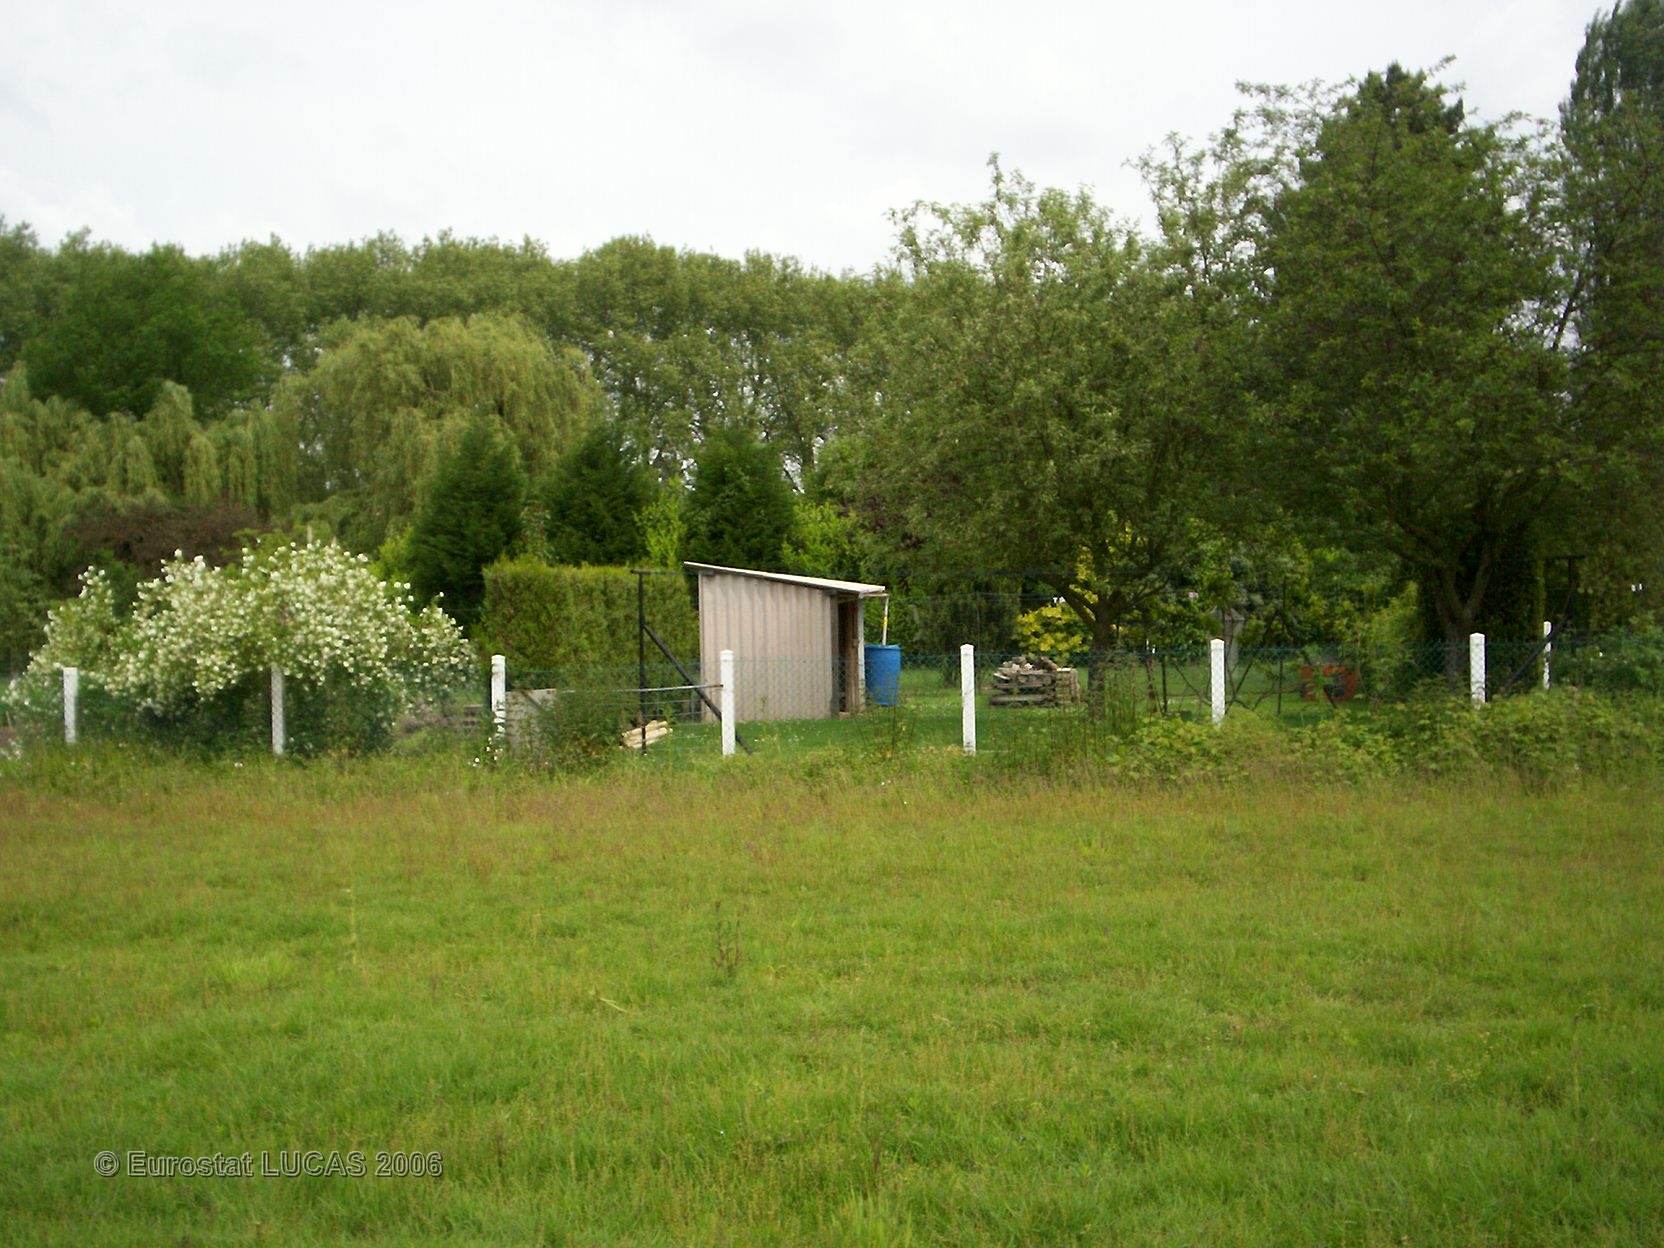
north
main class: Grassland
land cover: Grassland without tree/shrub cover
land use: Agriculture (excluding fallow land and kitchen gardens)
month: June
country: FR
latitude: 49.3349
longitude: 2.6817
